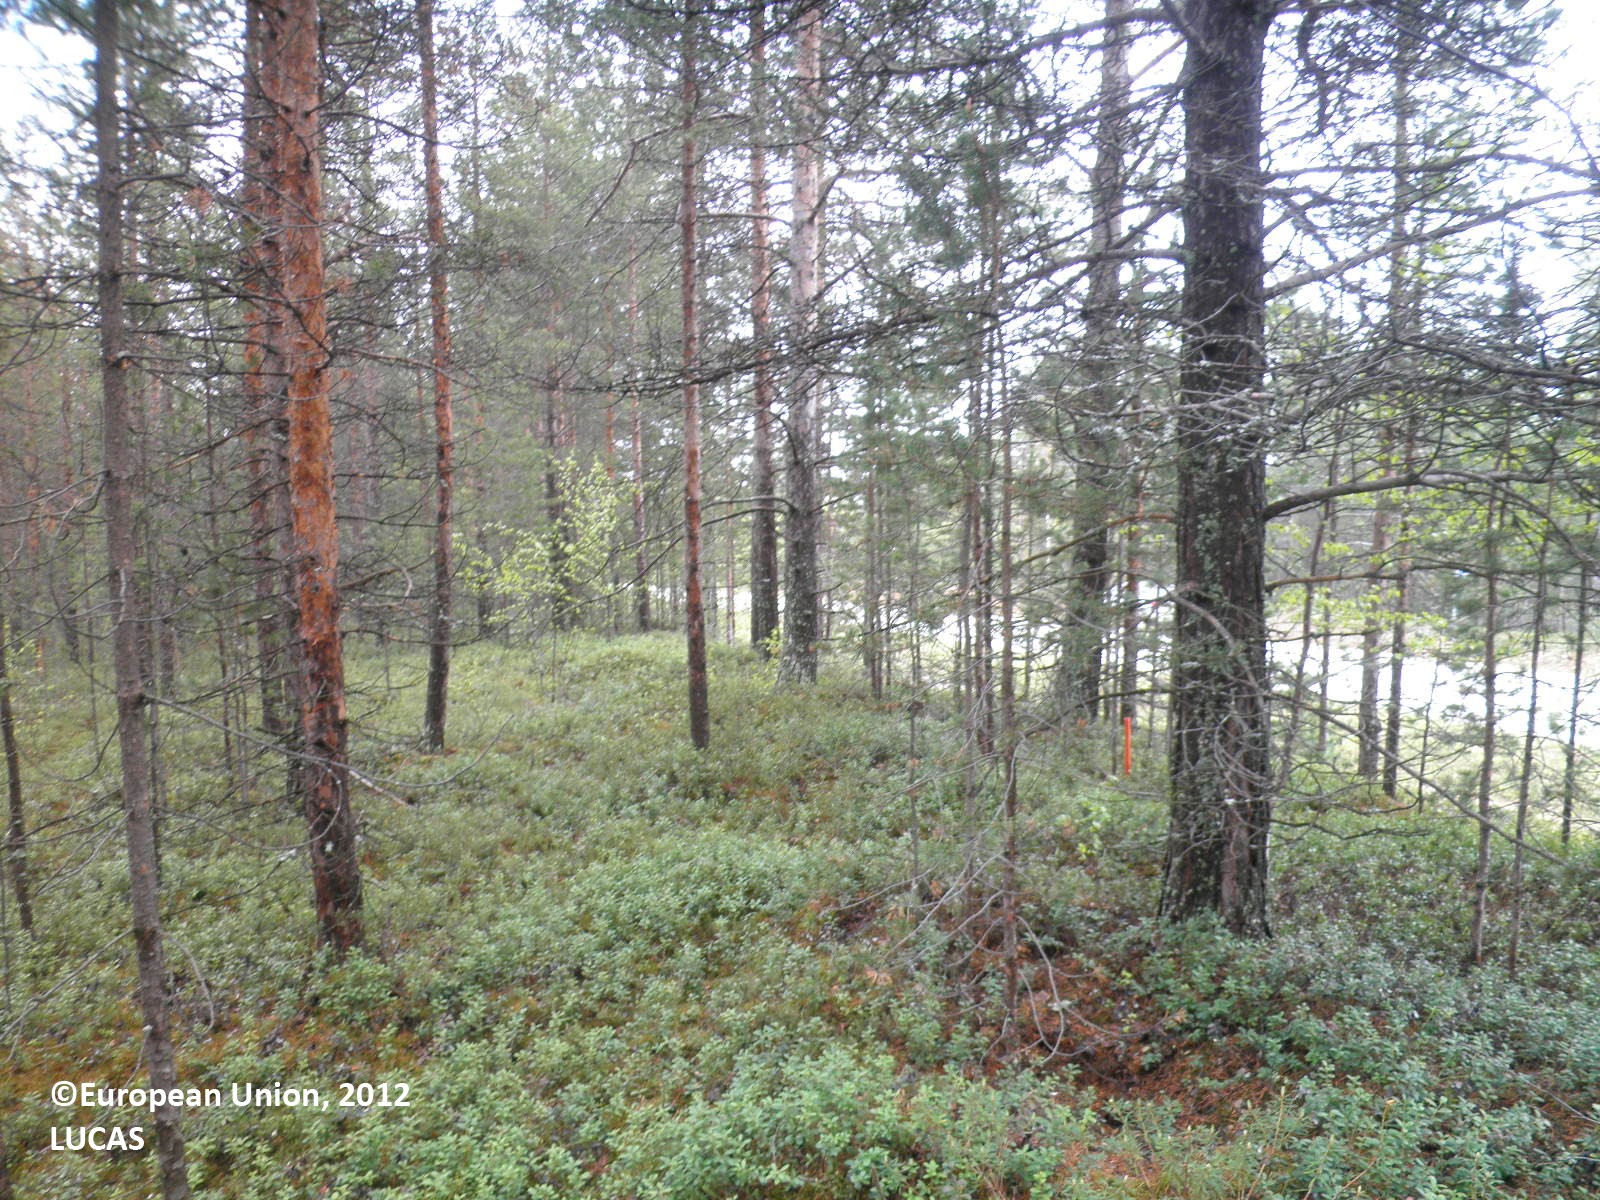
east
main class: Woodland
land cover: Pine dominated coniferous woodland
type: boreal forest
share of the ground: 25 - 50 %
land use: Forestry
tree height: > 5 m
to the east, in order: Pine dominated coniferous woodland; Rock outcrops; Paved roads, cycling and walking lanes; Grass margins; Electric lines; Pine dominated mixed woodland; Tracks; Electric lines; Pine dominated coniferous woodland
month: June
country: FI
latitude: 68.7070
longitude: 27.7763
